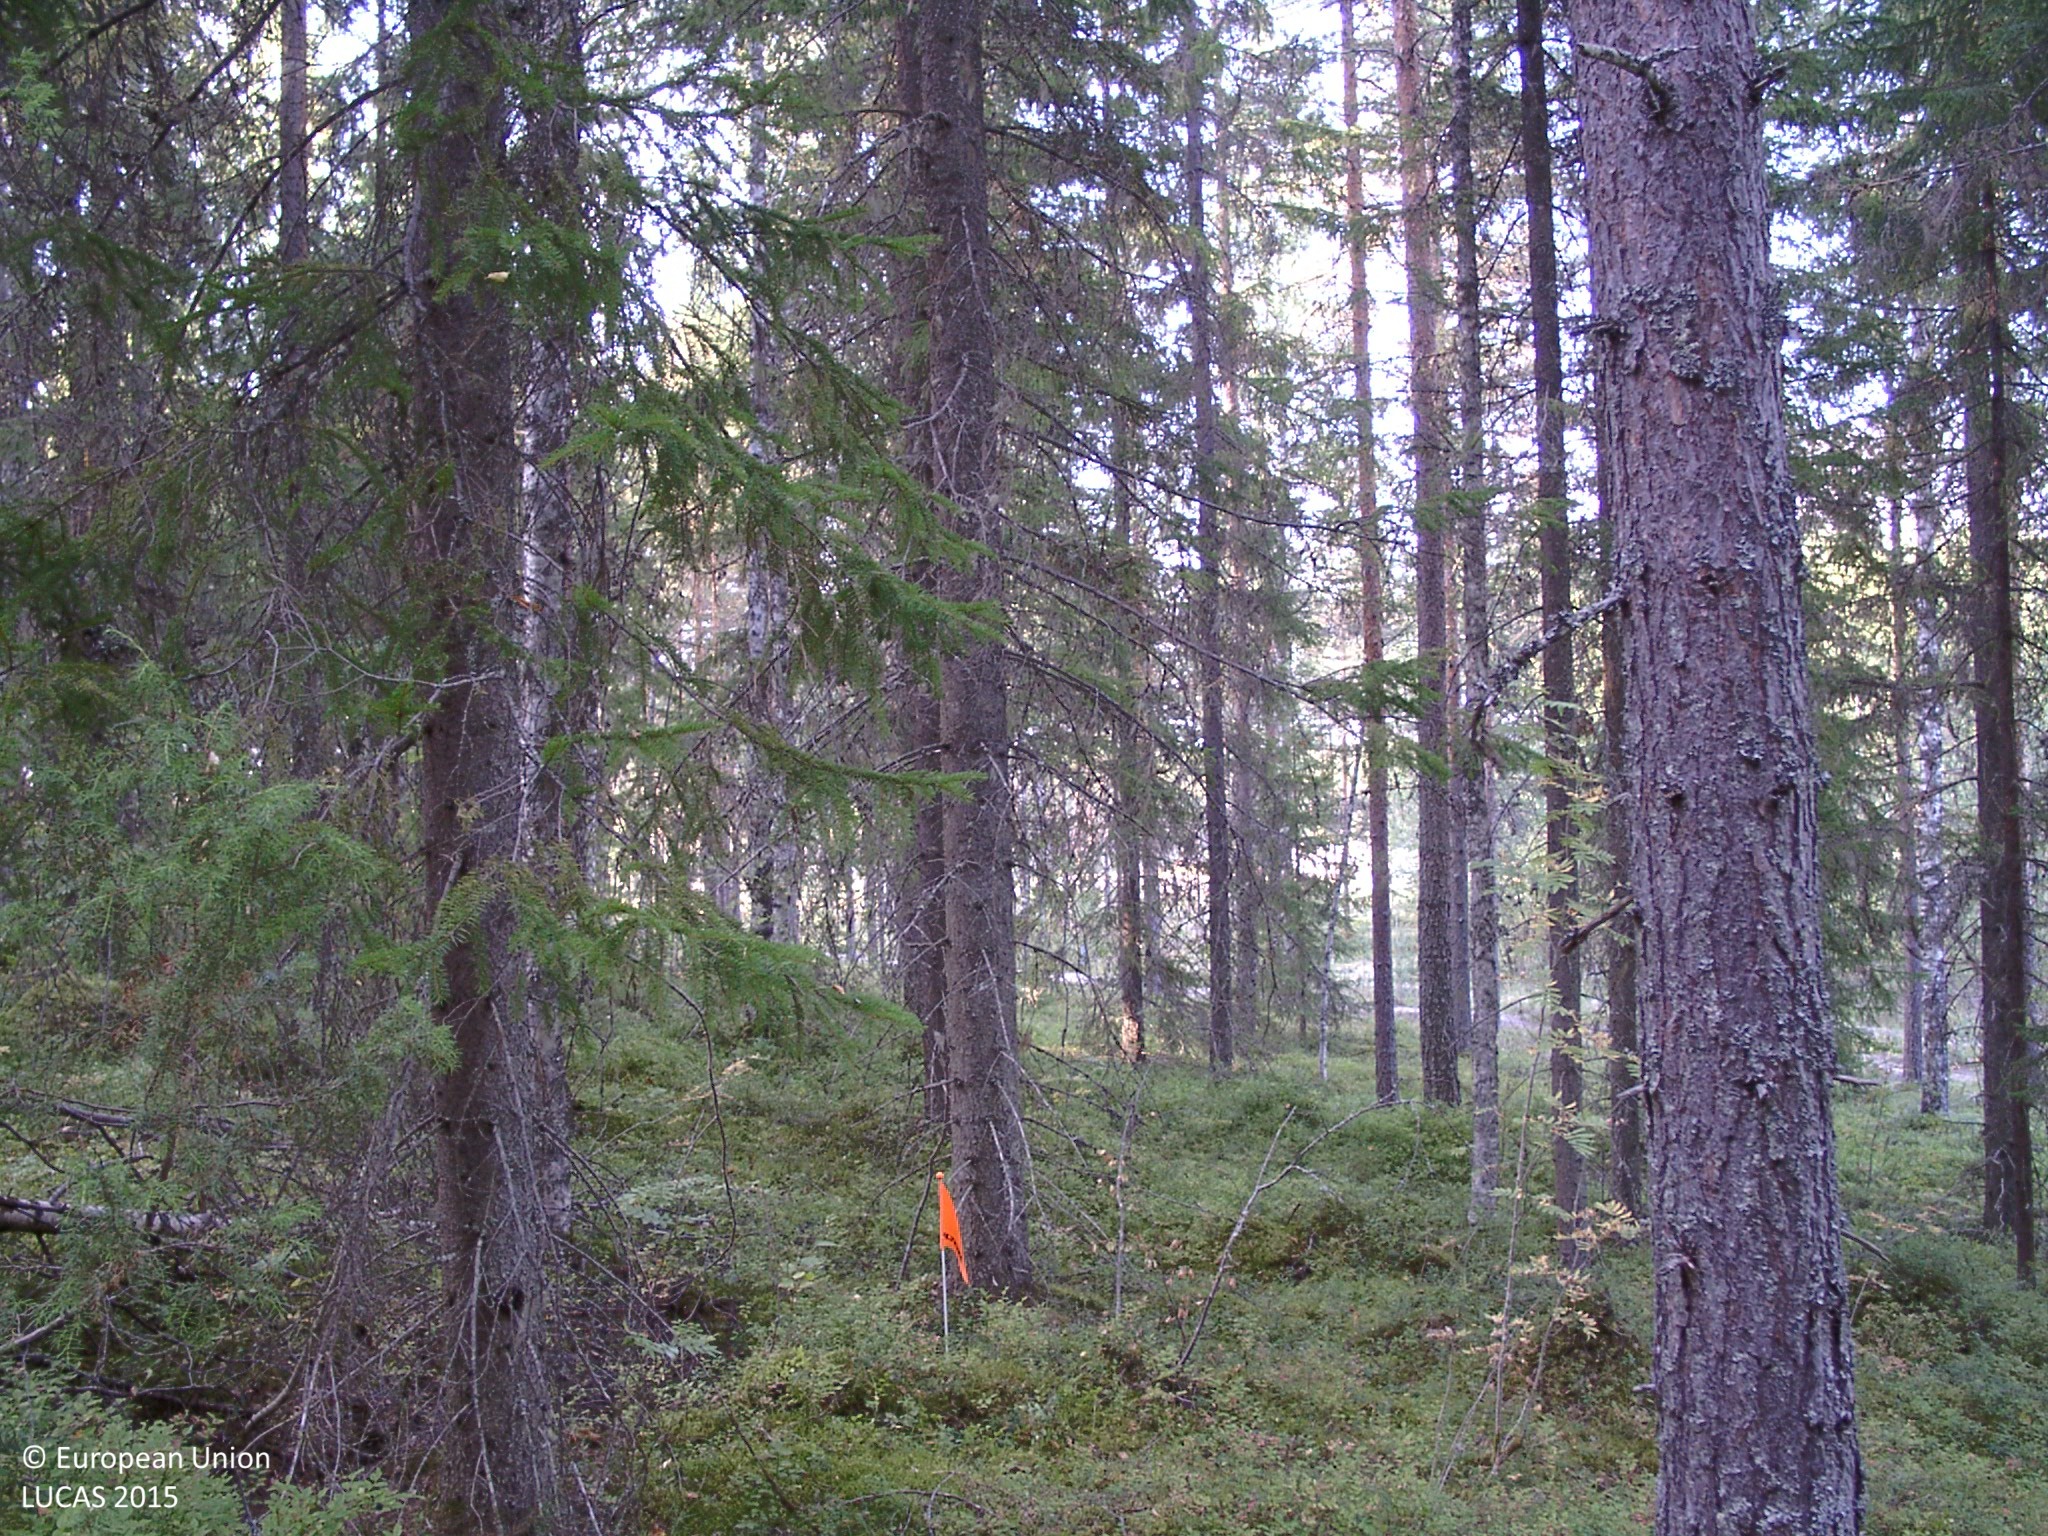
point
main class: Woodland
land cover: Spruce dominated mixed woodland
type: boreal forest
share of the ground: 50 - 75 %
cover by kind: coniferous forest trees 45 %, broadleaved forest trees 20 %, shrubs 20 %, lichens and mosses 15 %
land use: Forestry
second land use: Sport
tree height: > 5 m
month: August
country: FI
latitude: 61.8972
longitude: 25.1231
